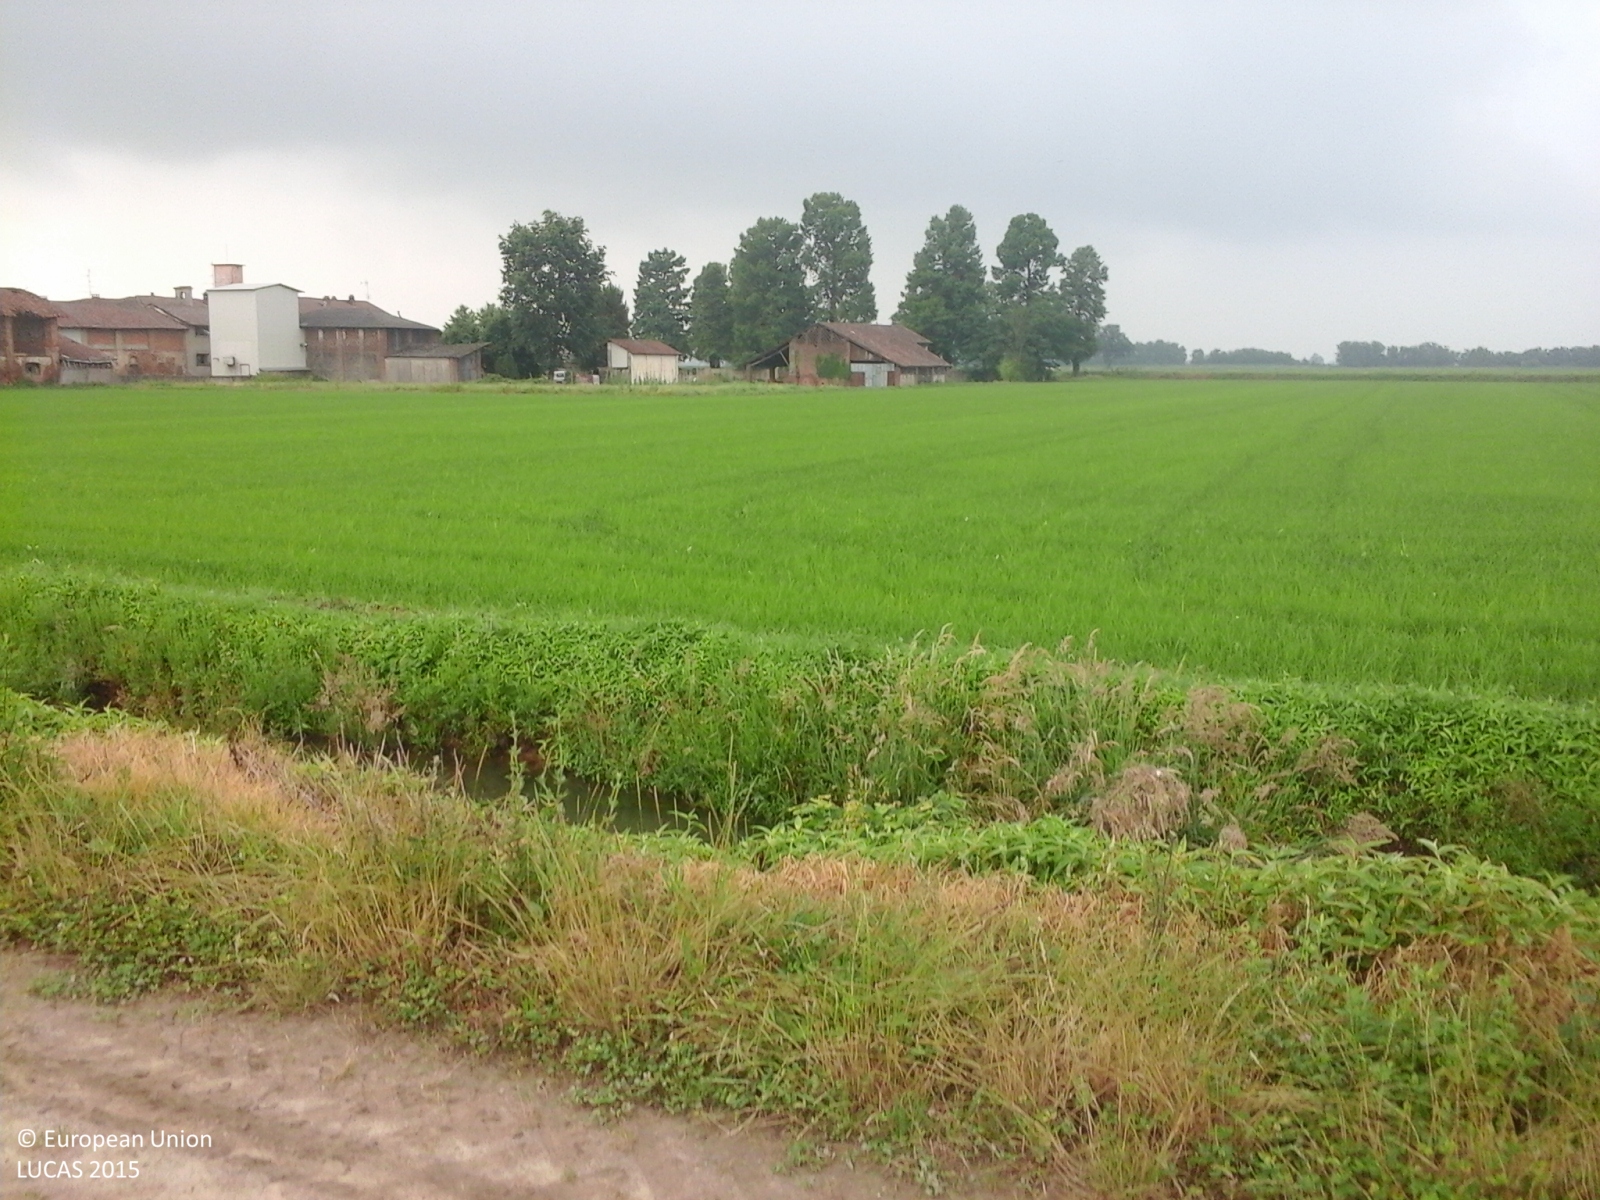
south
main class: Cropland
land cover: Rice
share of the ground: > 75 %
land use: Agriculture (excluding fallow land and kitchen gardens)
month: June
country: IT
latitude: 45.2066
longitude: 8.5893
